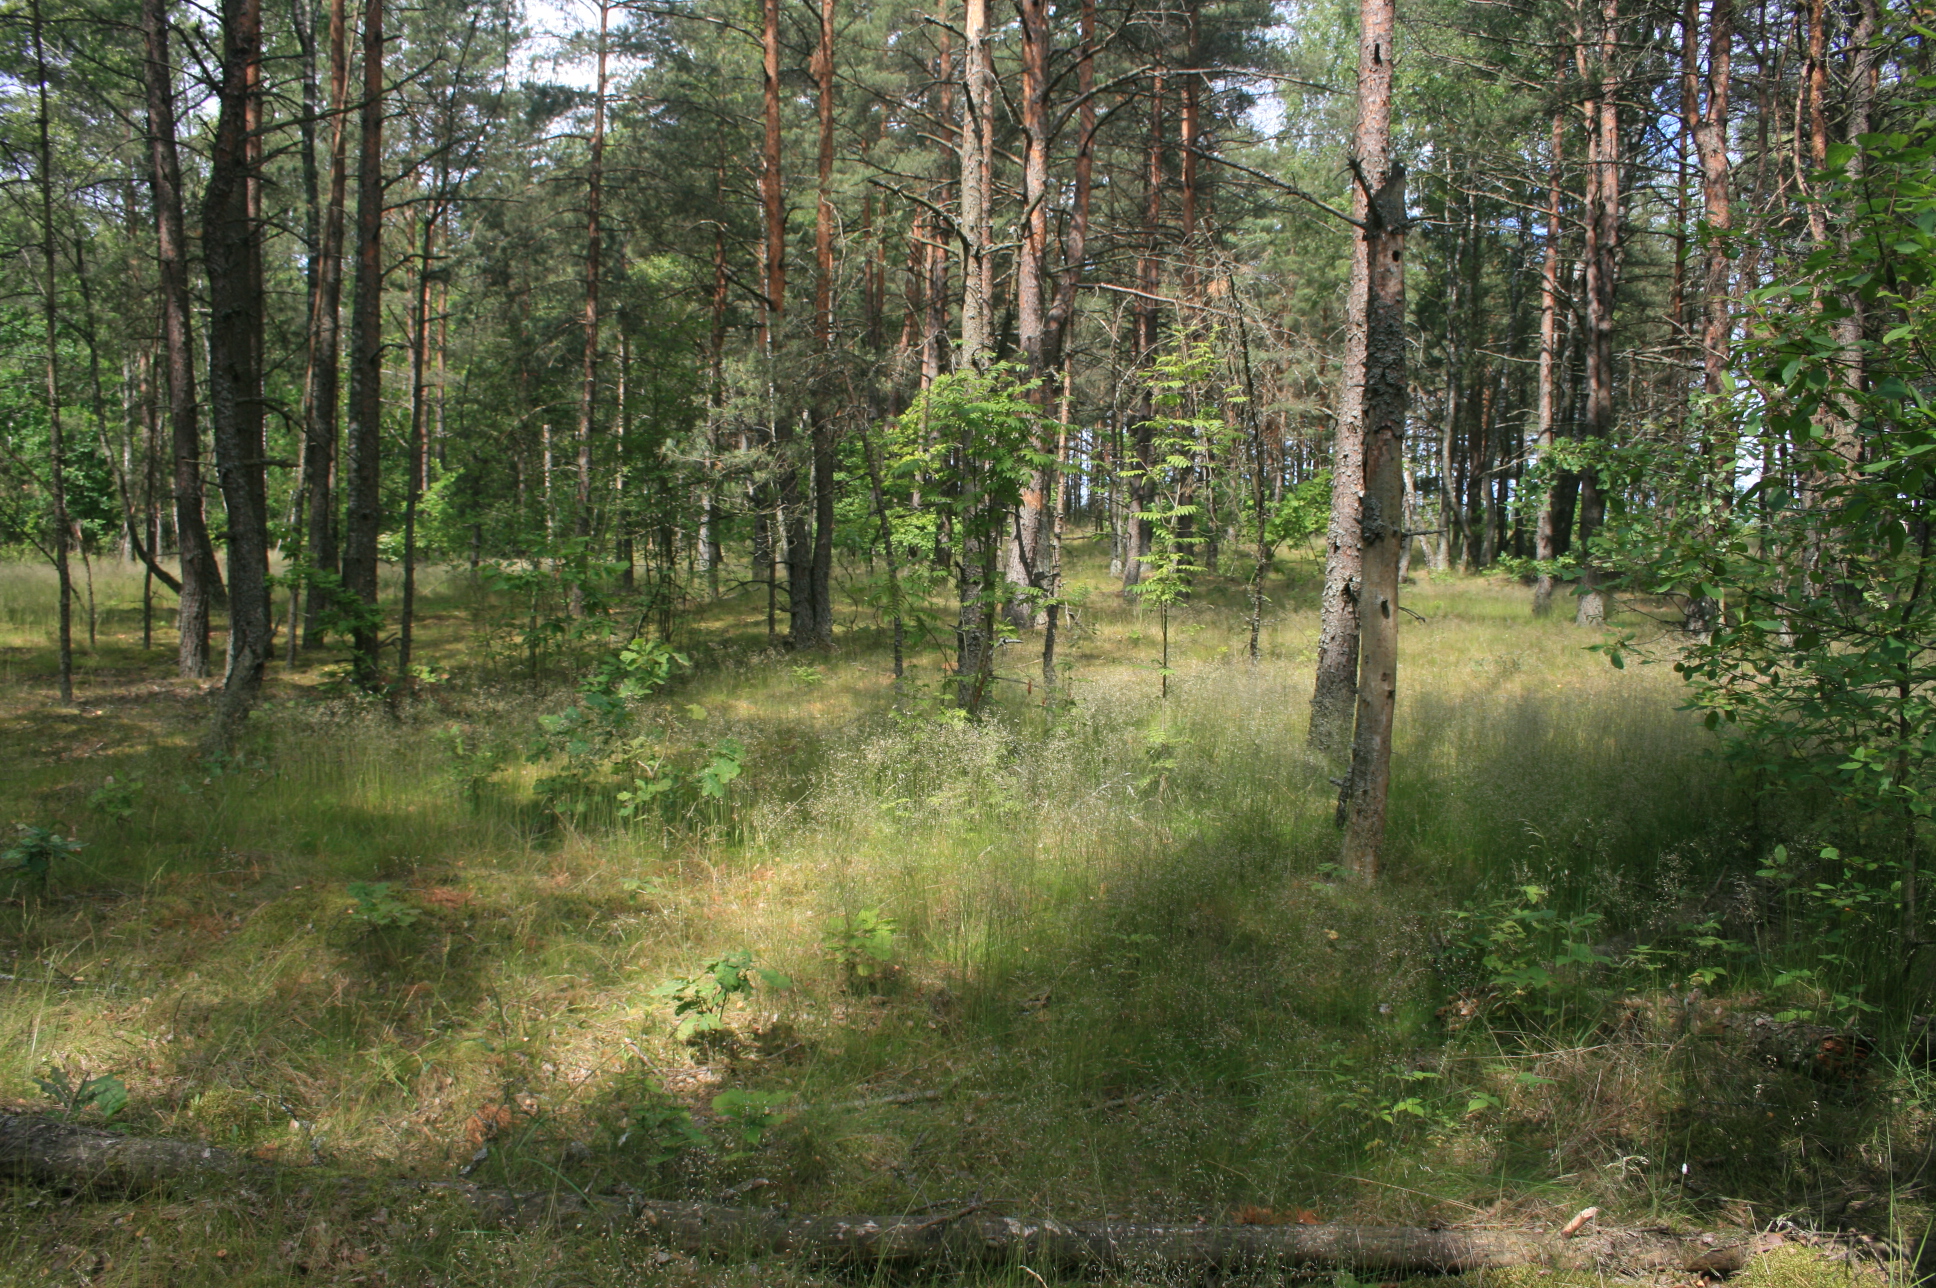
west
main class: Woodland
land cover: Pine dominated mixed woodland
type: hemiboreal forest and nemoral coniferous forest and mixed broadleaved-coniferous forest
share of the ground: > 75 %
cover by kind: coniferous forest trees 55 %, broadleaved forest trees 30 %, herbaceous plants 15 %
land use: Forestry
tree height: > 5 m
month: June
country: LT
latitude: 55.2114
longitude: 21.7267
